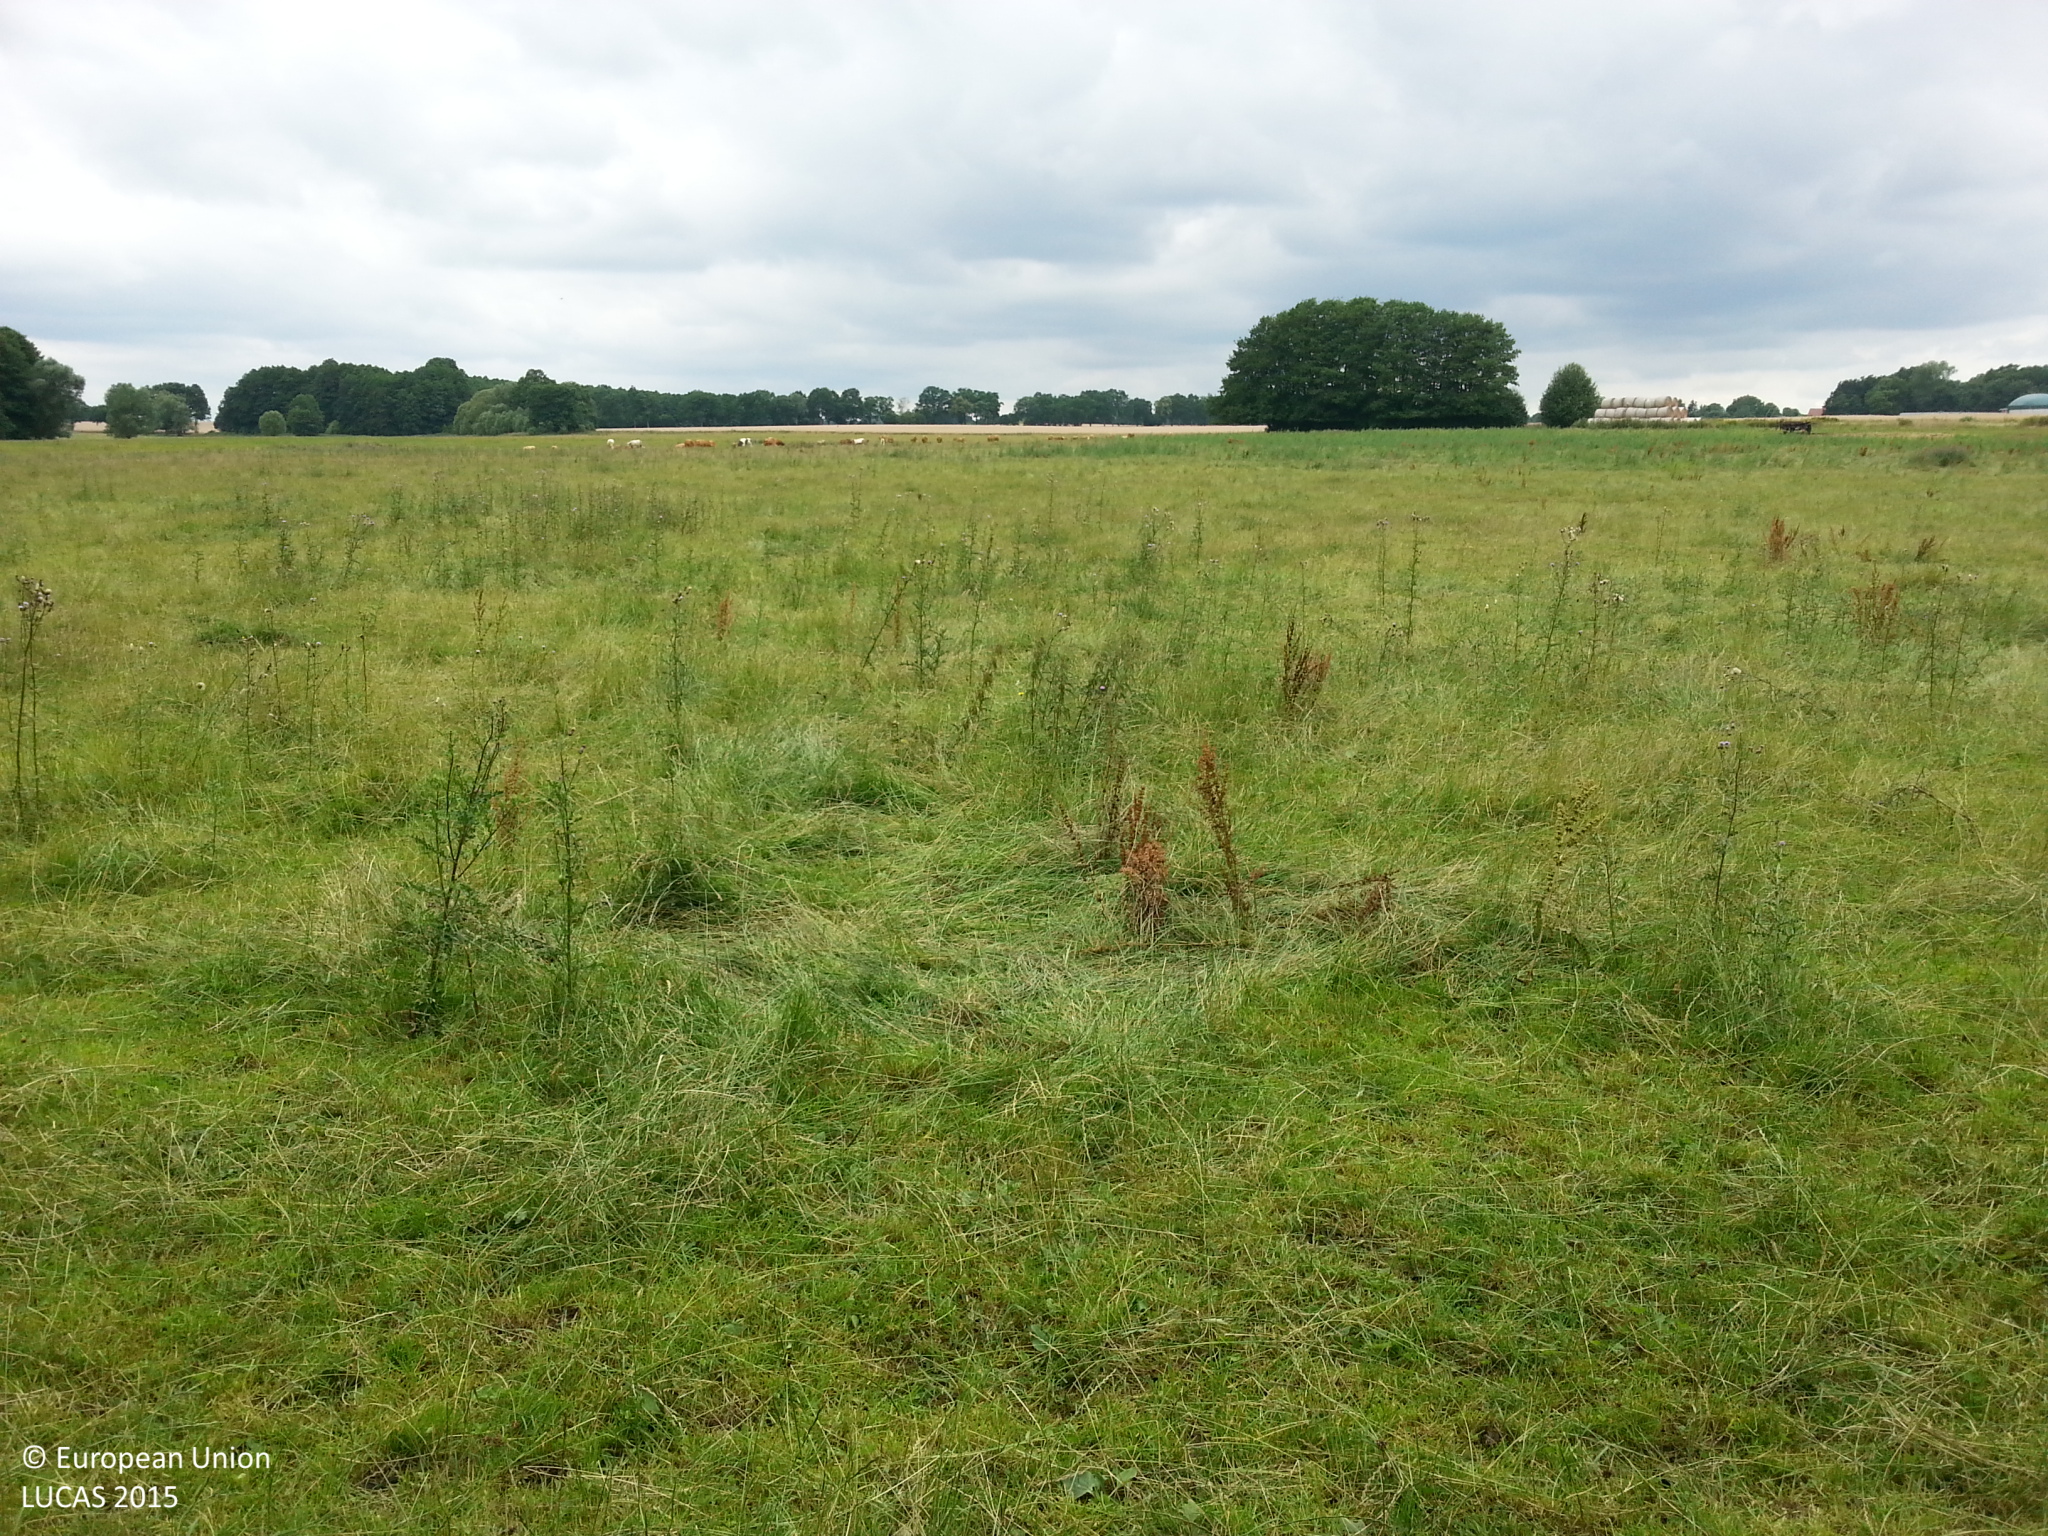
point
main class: Grassland
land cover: Grassland without tree/shrub cover
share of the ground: > 75 %
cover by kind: herbaceous plants 100 %
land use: Agriculture (excluding fallow land and kitchen gardens)
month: July
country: DE
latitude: 53.1994
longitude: 12.3496
